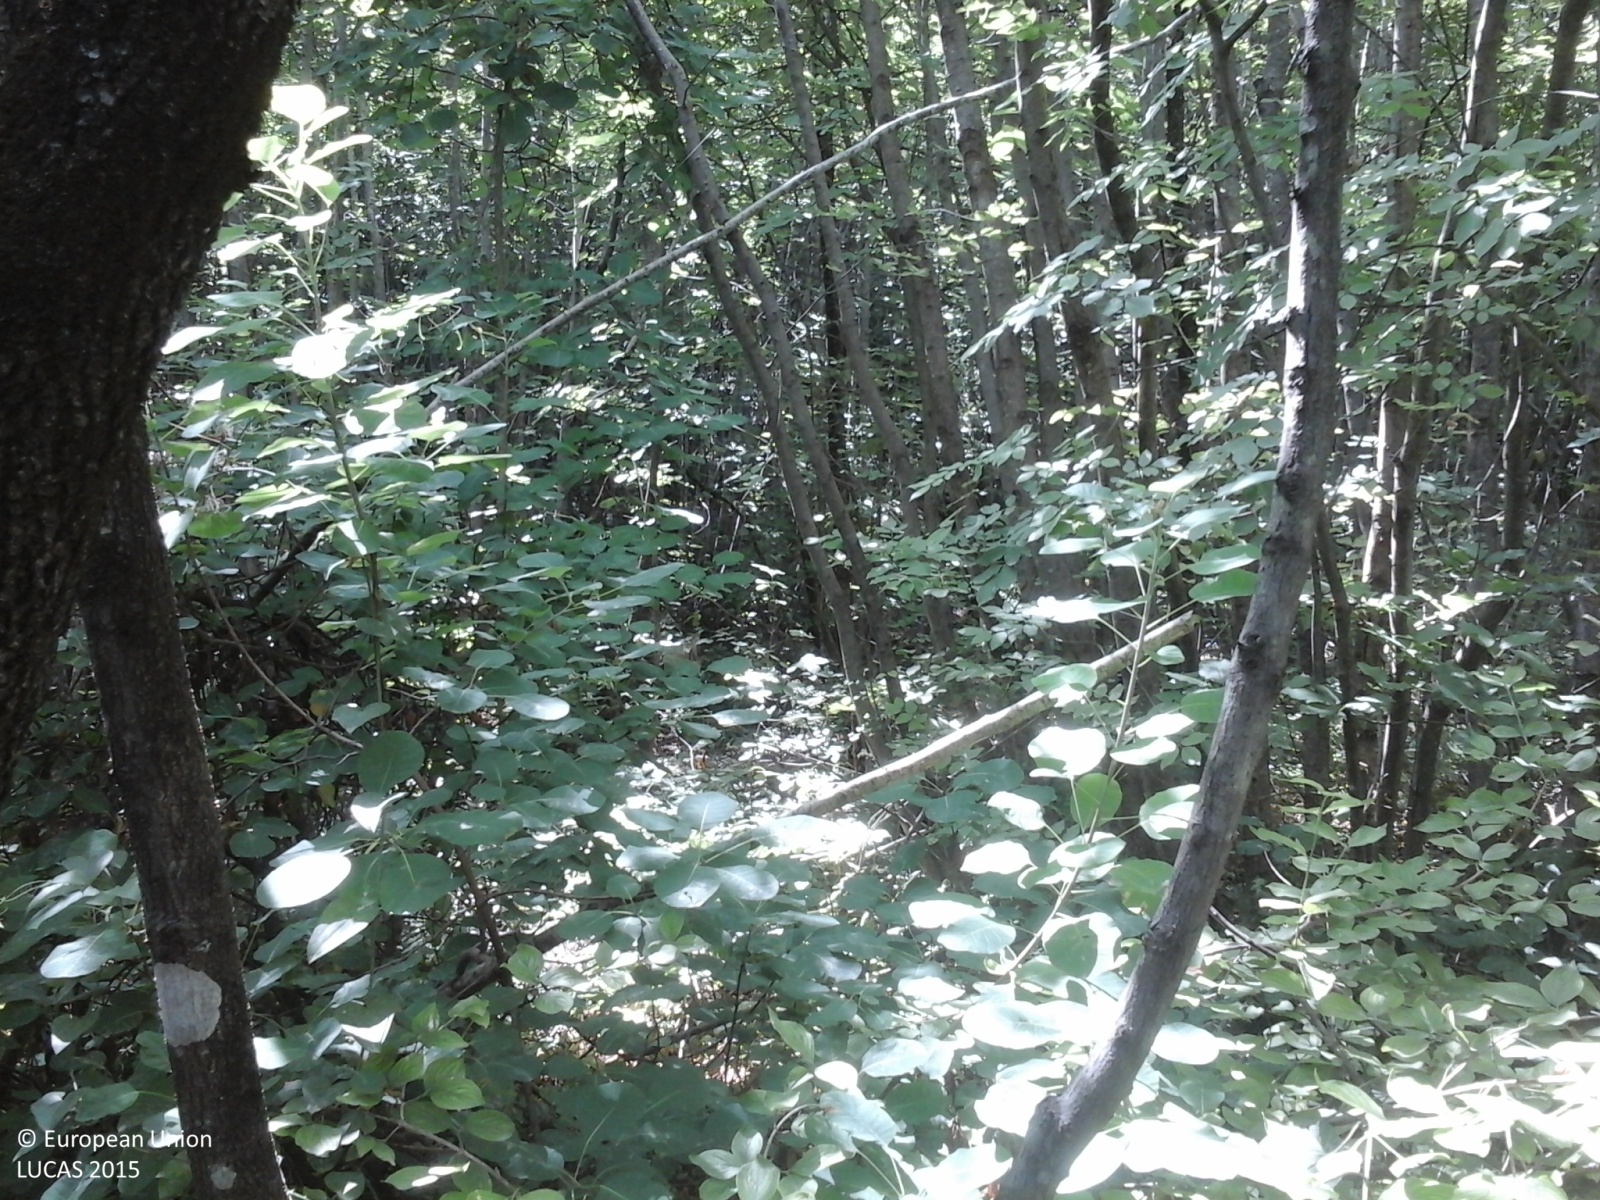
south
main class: Woodland
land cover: Broadleaved woodland
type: mountainous beech forest
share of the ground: > 75 %
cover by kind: broadleaved forest trees 95 %, coniferous forest trees 5 %
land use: Forestry
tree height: > 5 m
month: August
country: IT
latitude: 43.3071
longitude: 13.2339
